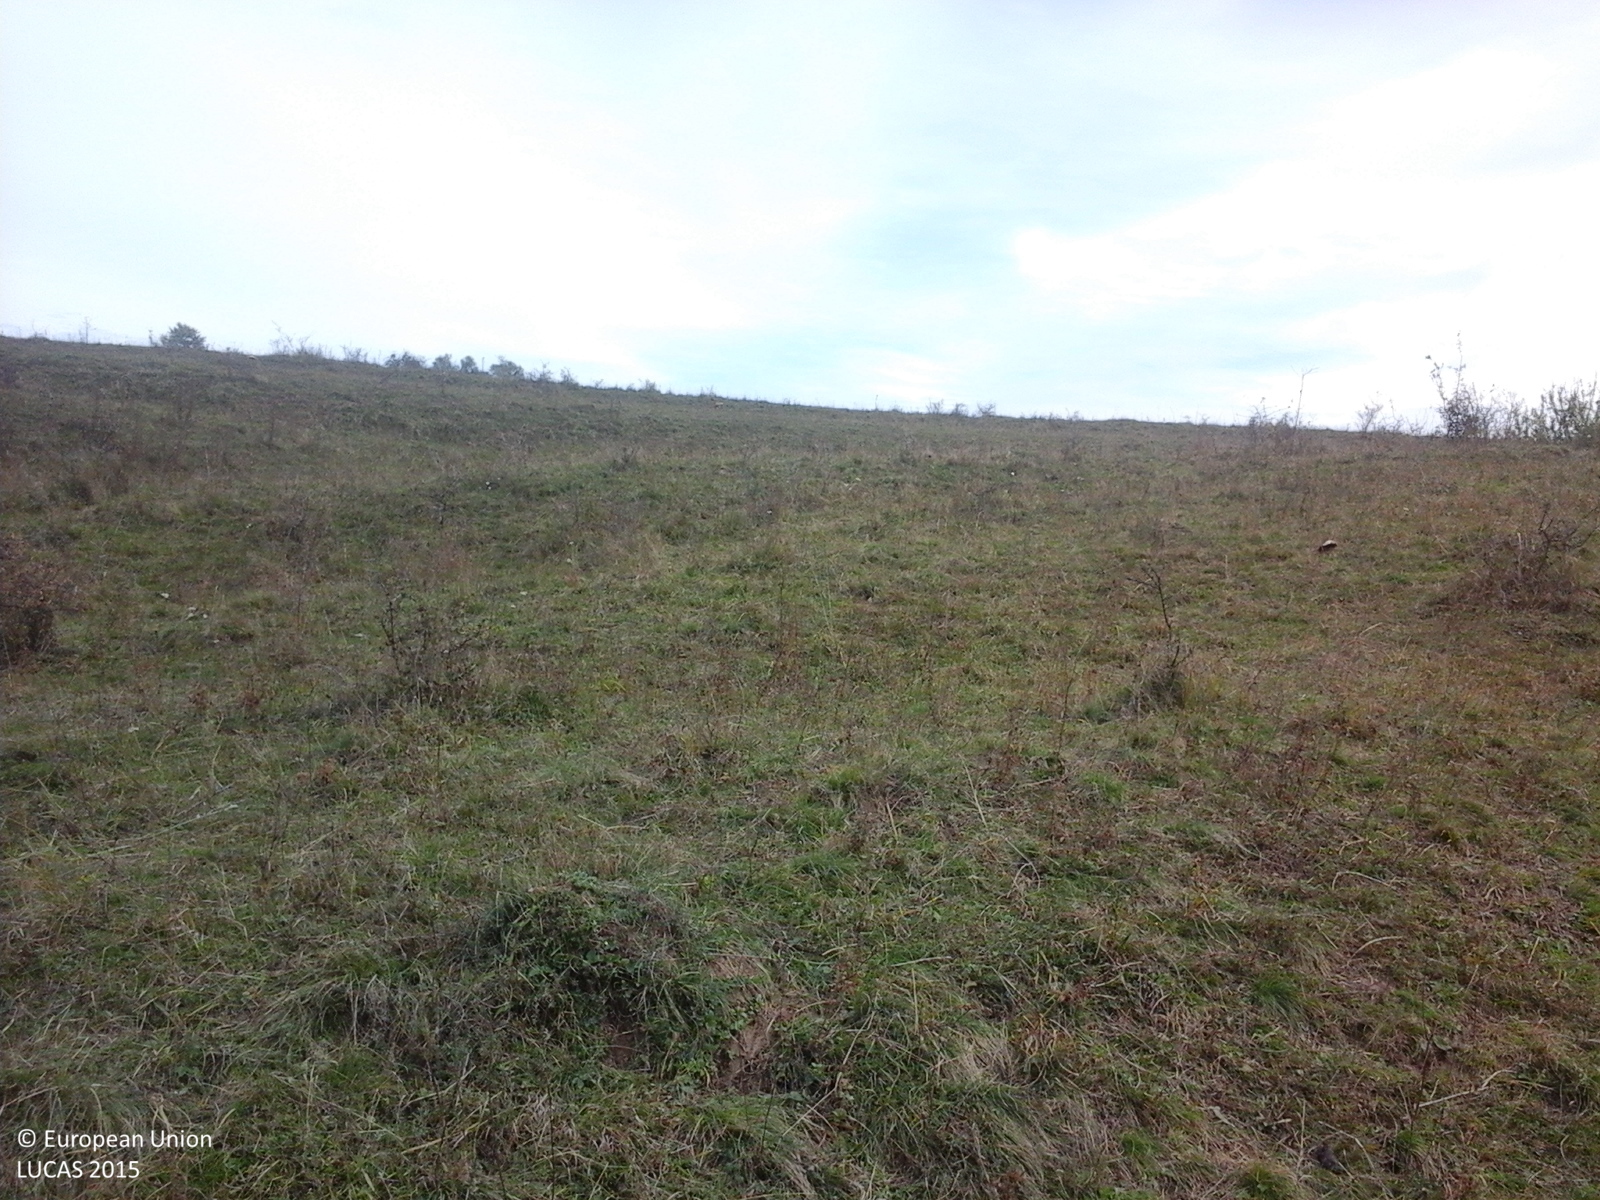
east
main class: Grassland
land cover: Spontaneously vegetated surfaces
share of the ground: > 75 %
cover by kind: herbaceous plants 100 %
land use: Fallow land
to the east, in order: Spontaneously vegetated surfaces; Rape and turnip rape
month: October
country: RO
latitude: 45.8612
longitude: 25.0740
